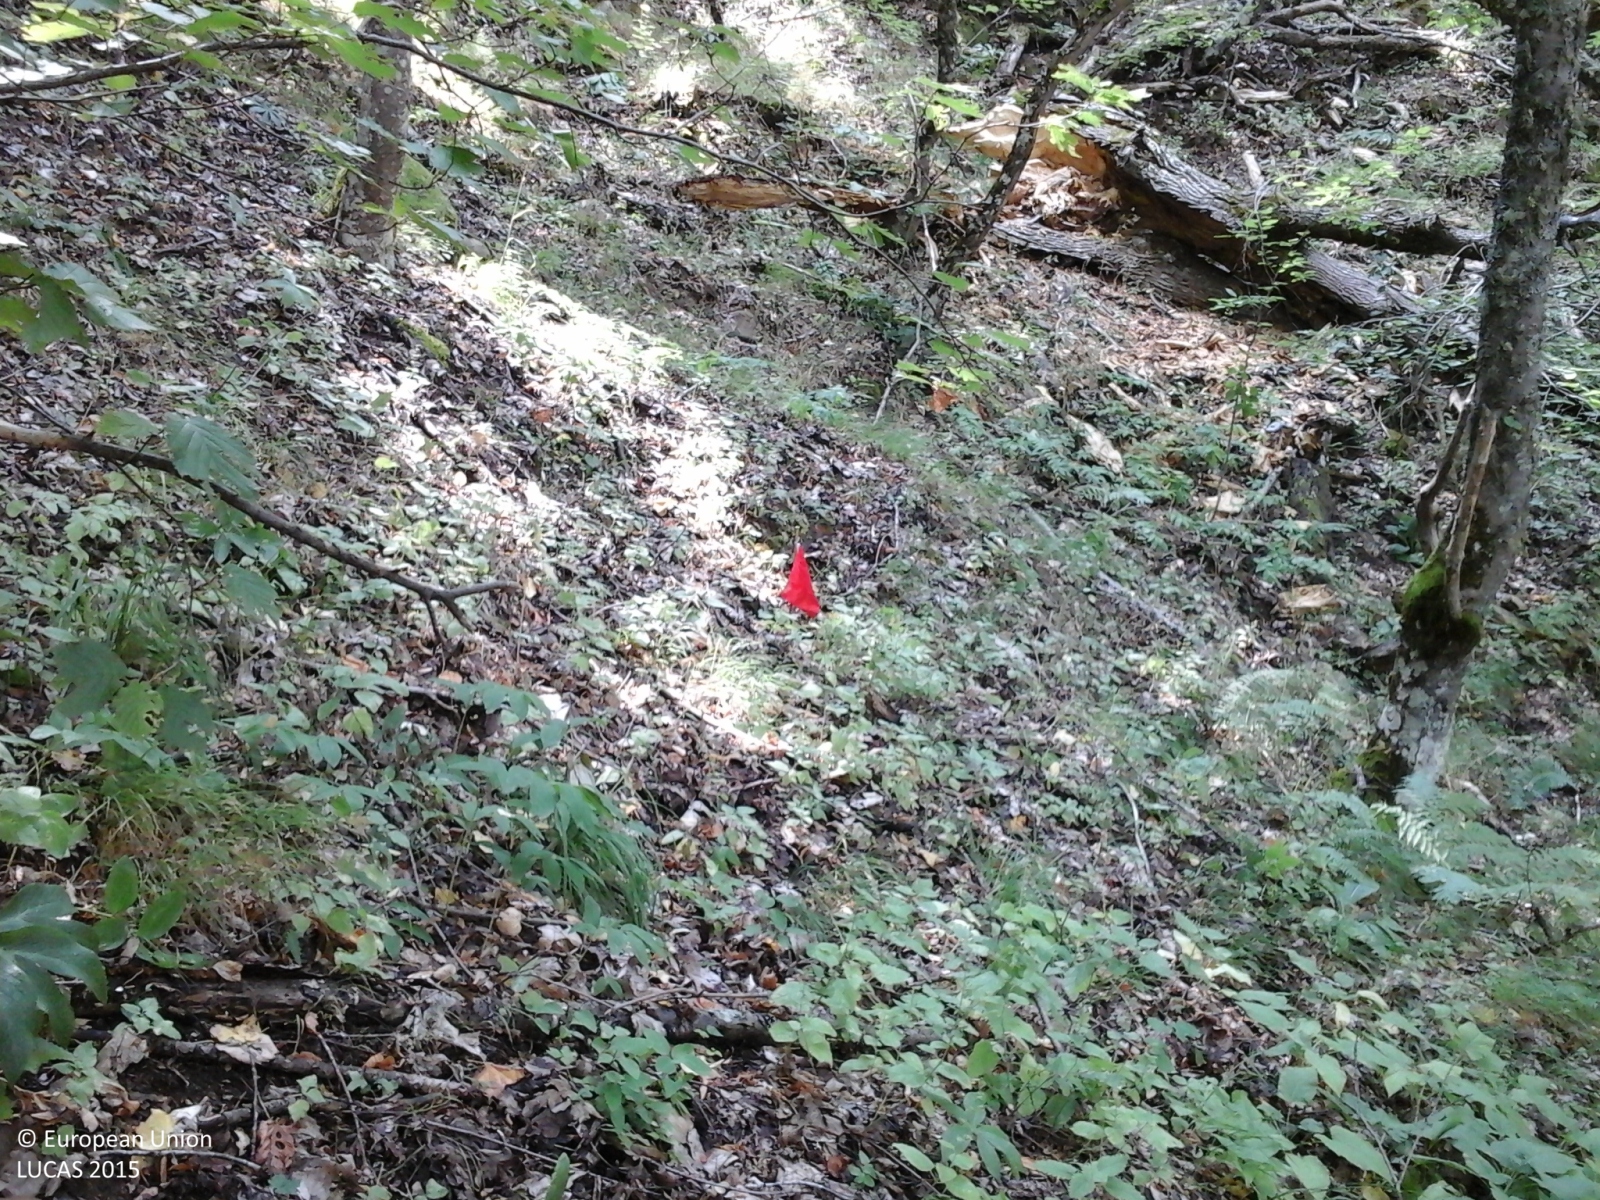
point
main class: Woodland
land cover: Broadleaved woodland
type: beech forest
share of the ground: > 75 %
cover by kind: broadleaved forest trees 85 %, herbaceous plants 15 %
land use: Forestry
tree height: > 5 m
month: August
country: GR
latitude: 40.3892
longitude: 21.0489
